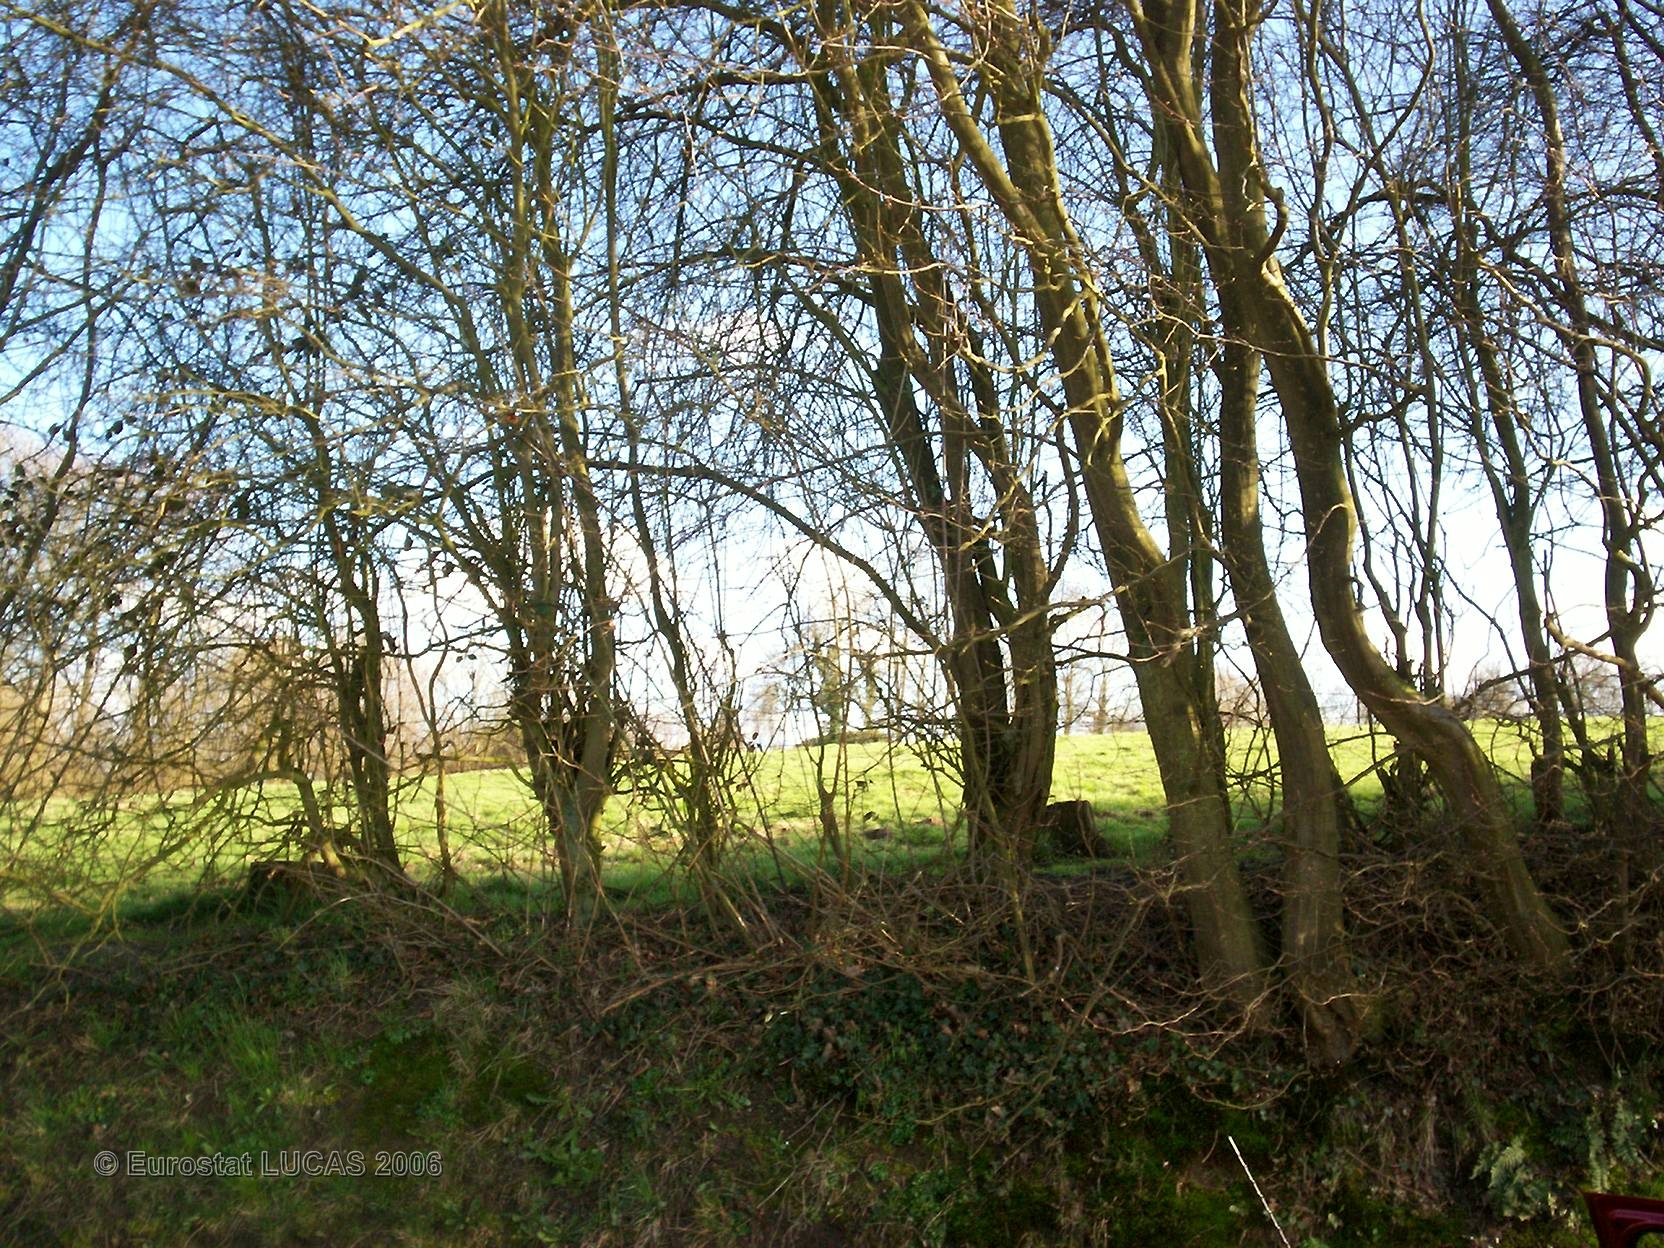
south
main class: Grassland
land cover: Grassland without tree/shrub cover
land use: Agriculture (excluding fallow land and kitchen gardens)
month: April
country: FR
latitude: 49.6437
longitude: 0.9617
